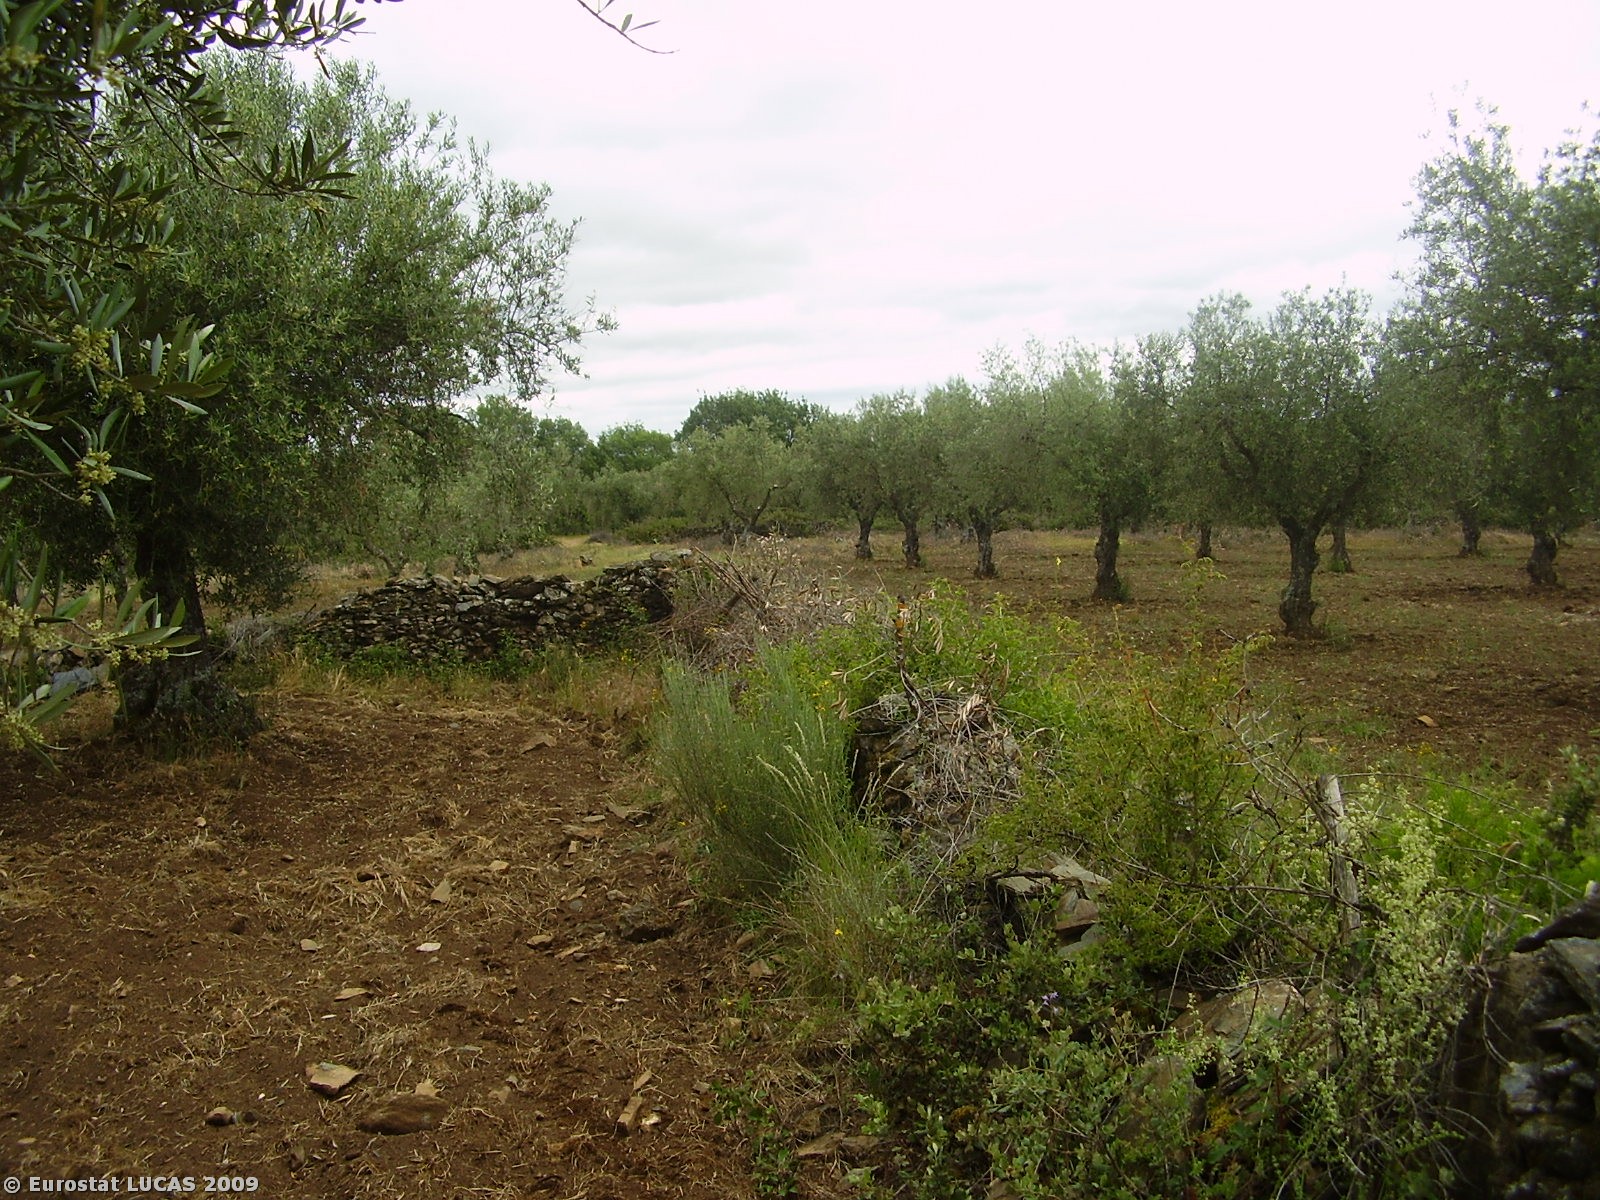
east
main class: Cropland
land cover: Olive groves
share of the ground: 10 - 25 %
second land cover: Bare land
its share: > 75 %
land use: Agriculture (excluding fallow land and kitchen gardens)
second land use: Unused
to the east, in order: Olive groves; Bare land; Olive groves; Grass margins; Dry stone walls; Olive groves; Shruby margins; Dry stone walls; Shruby margins; Olive groves; Grassland without tree/shrub cover; Broadleaved woodland; Dry stone walls; Shruby margins; Tracks; Shruby margins; Dry stone walls; Broadleaved woodland; Grassland without tree/shrub cover
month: June
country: PT
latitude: 41.5540
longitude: -6.7875
